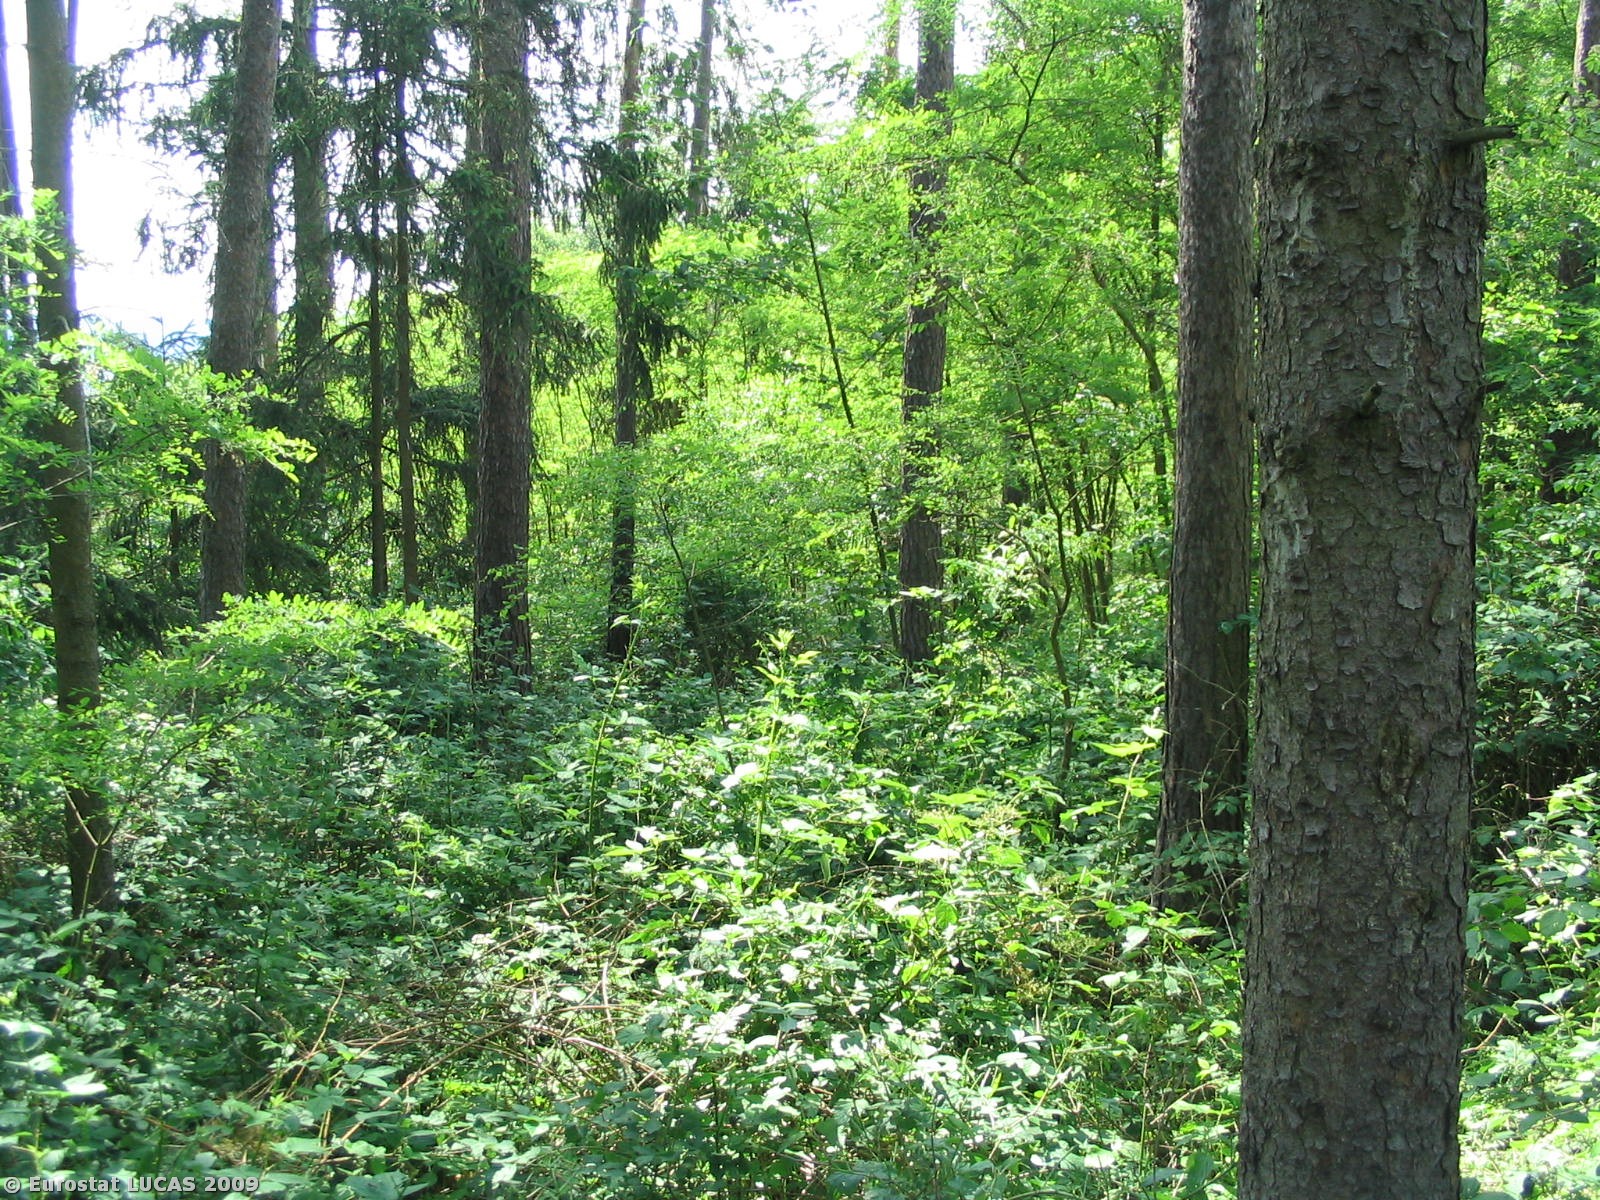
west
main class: Woodland
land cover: Mixed woodland
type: hemiboreal forest and nemoral coniferous forest and mixed broadleaved-coniferous forest
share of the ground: > 75 %
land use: Forestry
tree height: > 5 m
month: June
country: CZ
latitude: 49.3334
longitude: 16.4609
